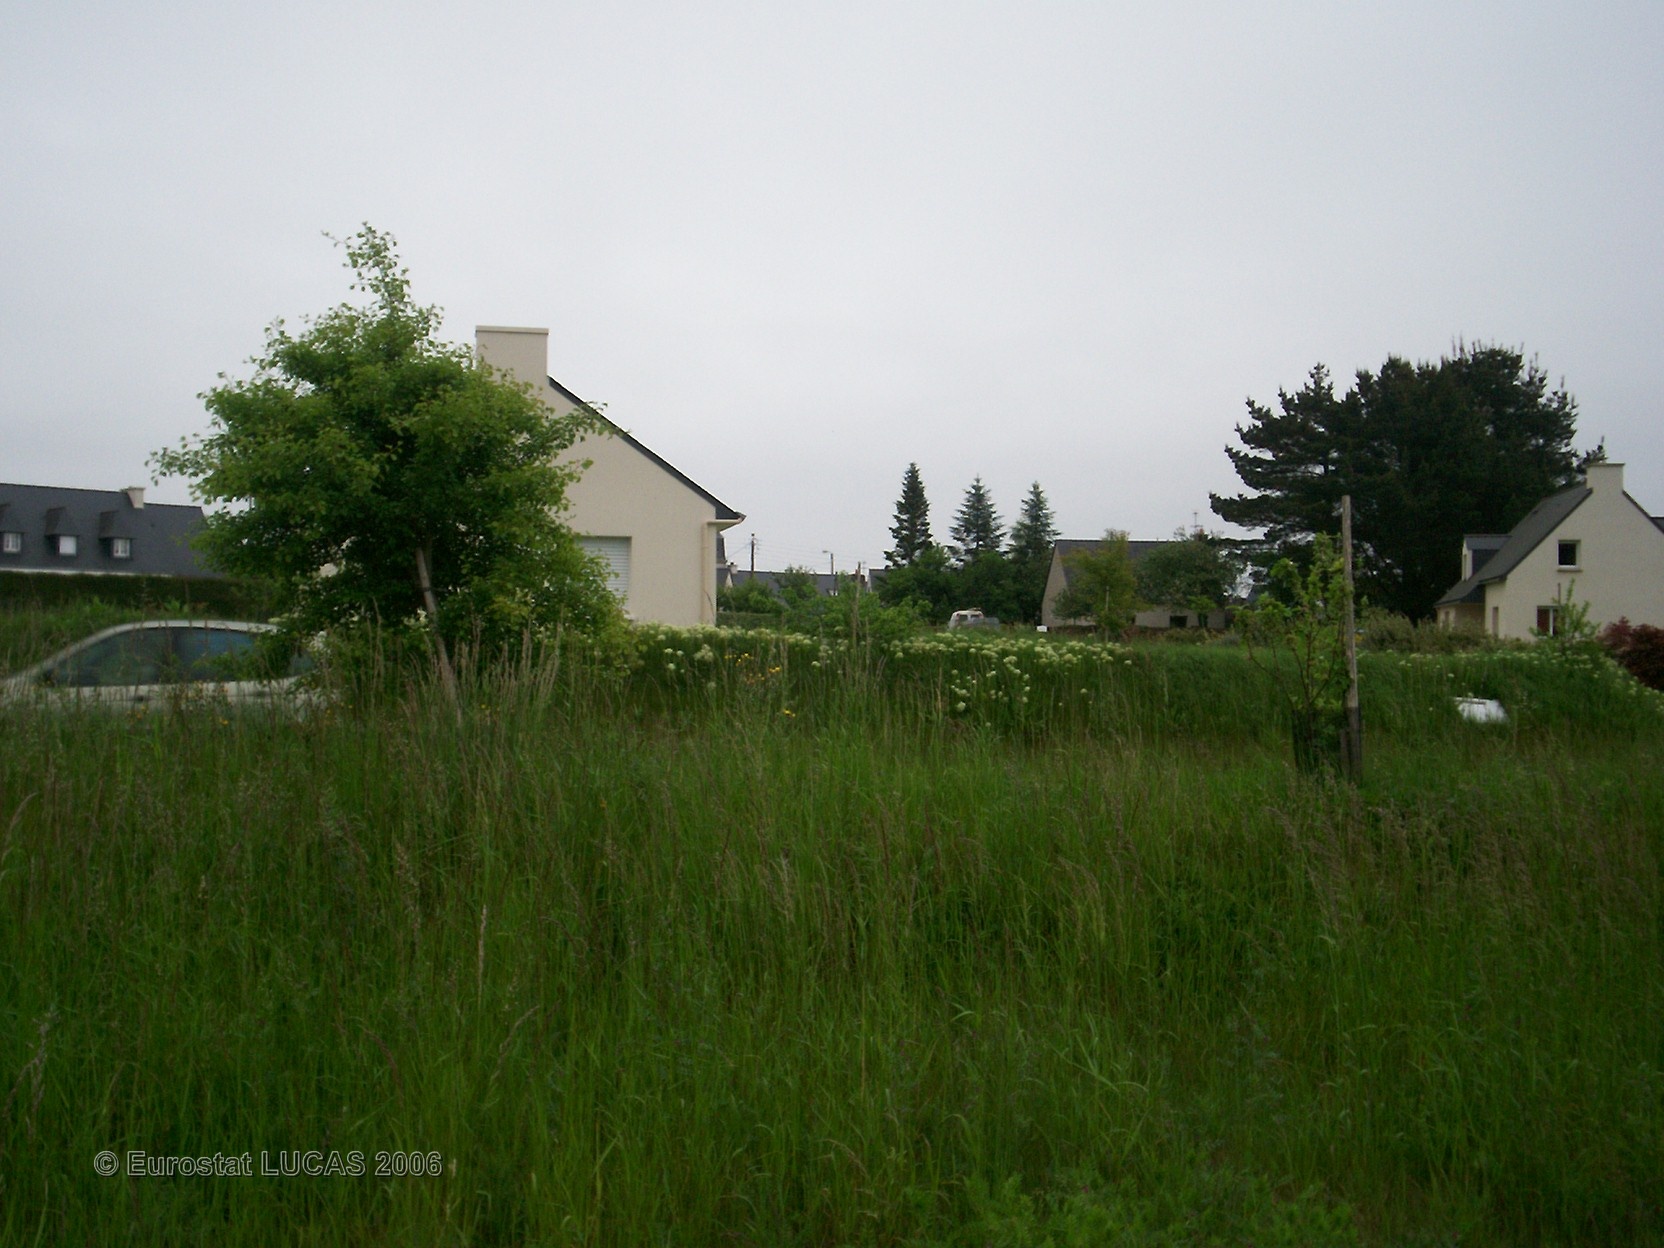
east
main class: Grassland
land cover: Grassland without tree/shrub cover
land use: Fallow land
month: May
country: FR
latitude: 47.7810
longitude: -3.5699
